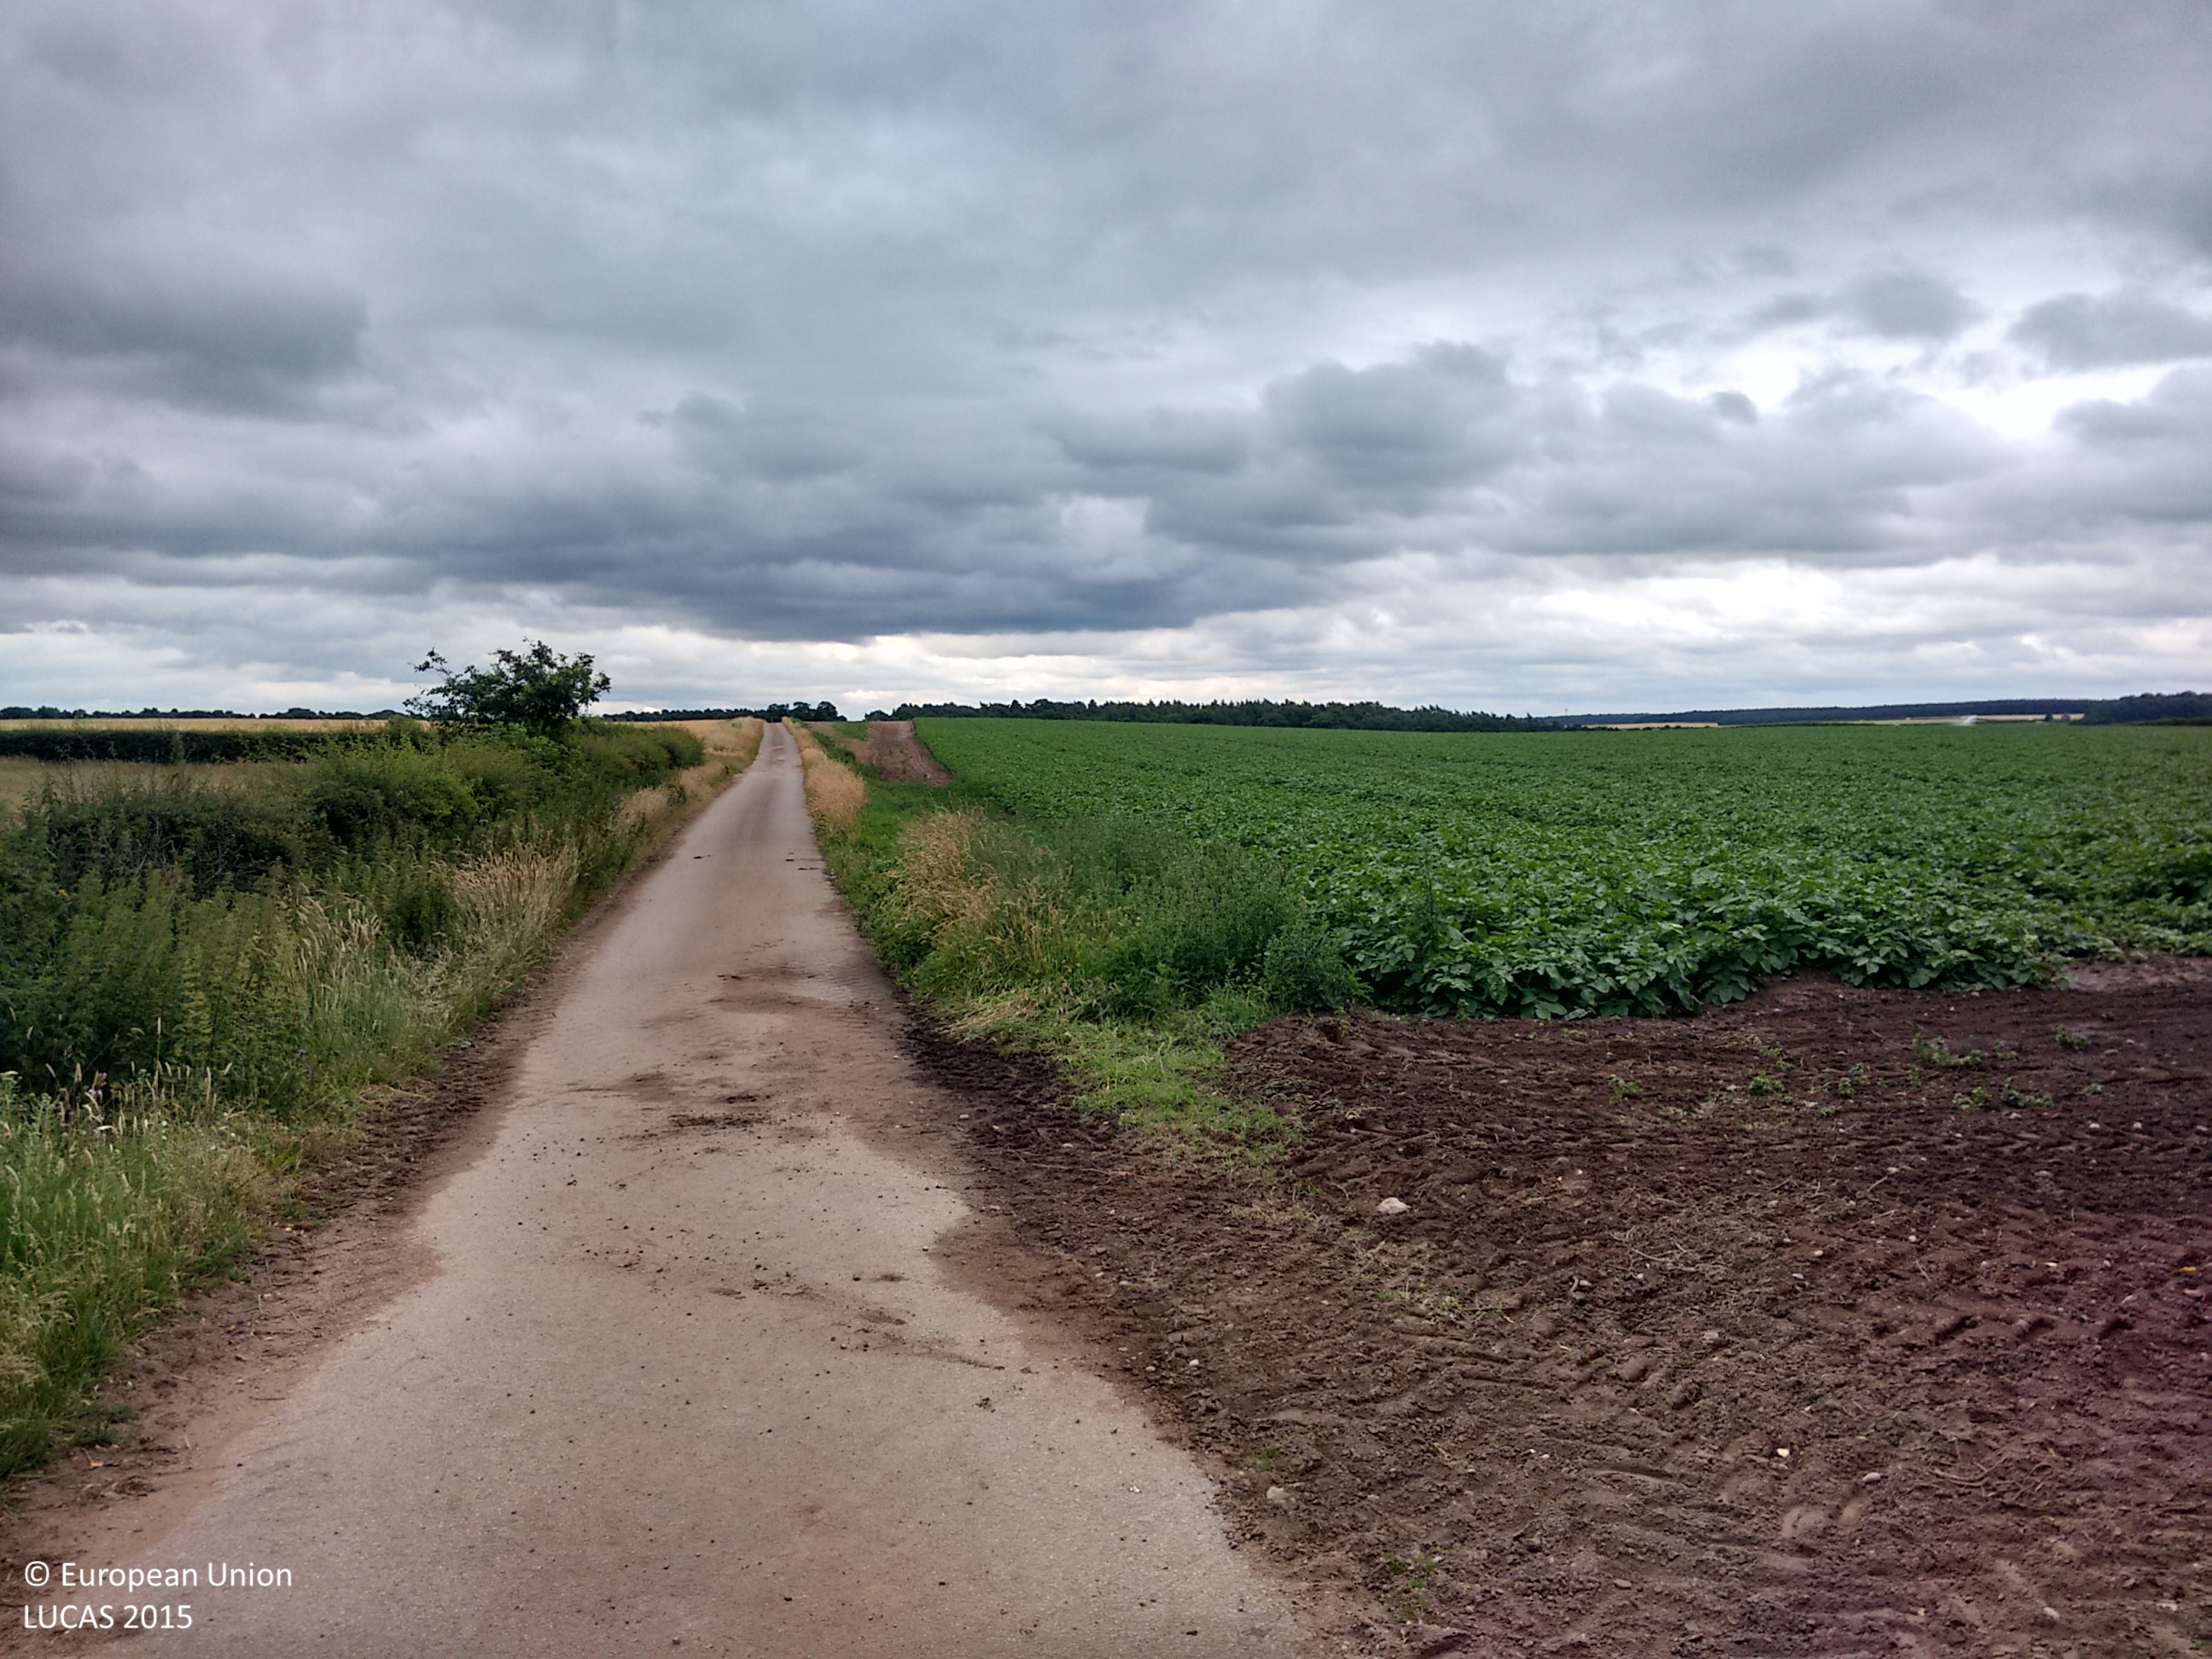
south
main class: Cropland
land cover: Potatoes
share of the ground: > 75 %
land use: Agriculture (excluding fallow land and kitchen gardens)
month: July
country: GB
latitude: 53.3656
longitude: -1.0598
